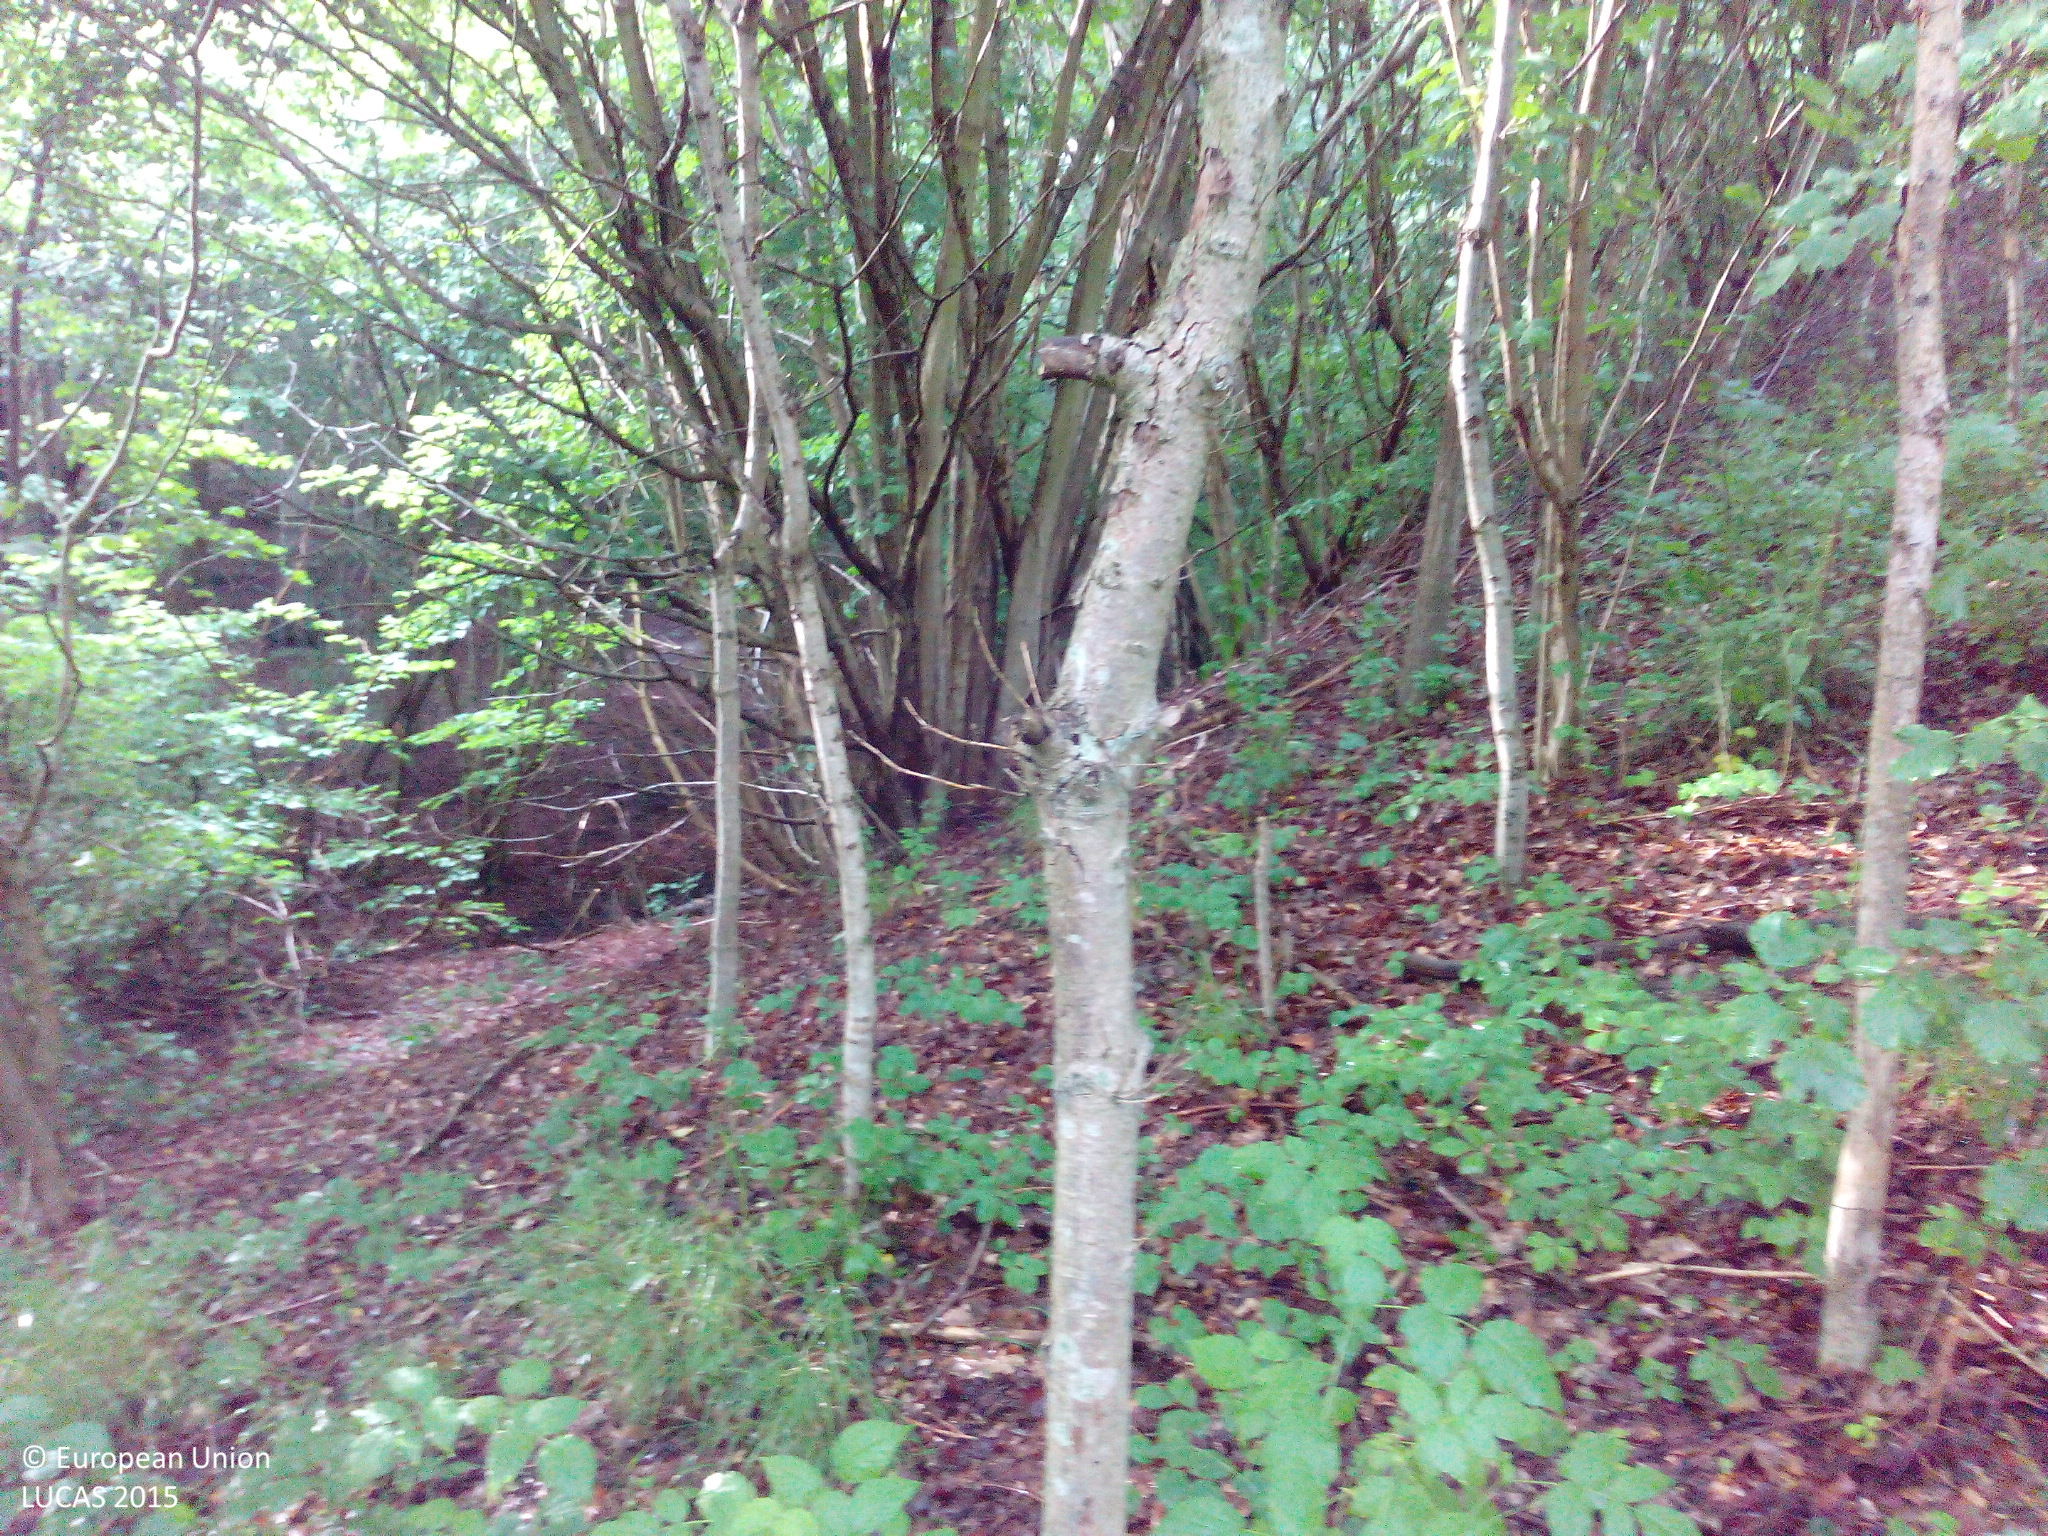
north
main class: Woodland
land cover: Broadleaved woodland
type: acidophilous oak and oak-birch forest
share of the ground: > 75 %
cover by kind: broadleaved forest trees 100 %
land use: Forestry
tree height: > 5 m
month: July
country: DK
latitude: 55.9151
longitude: 12.3178
